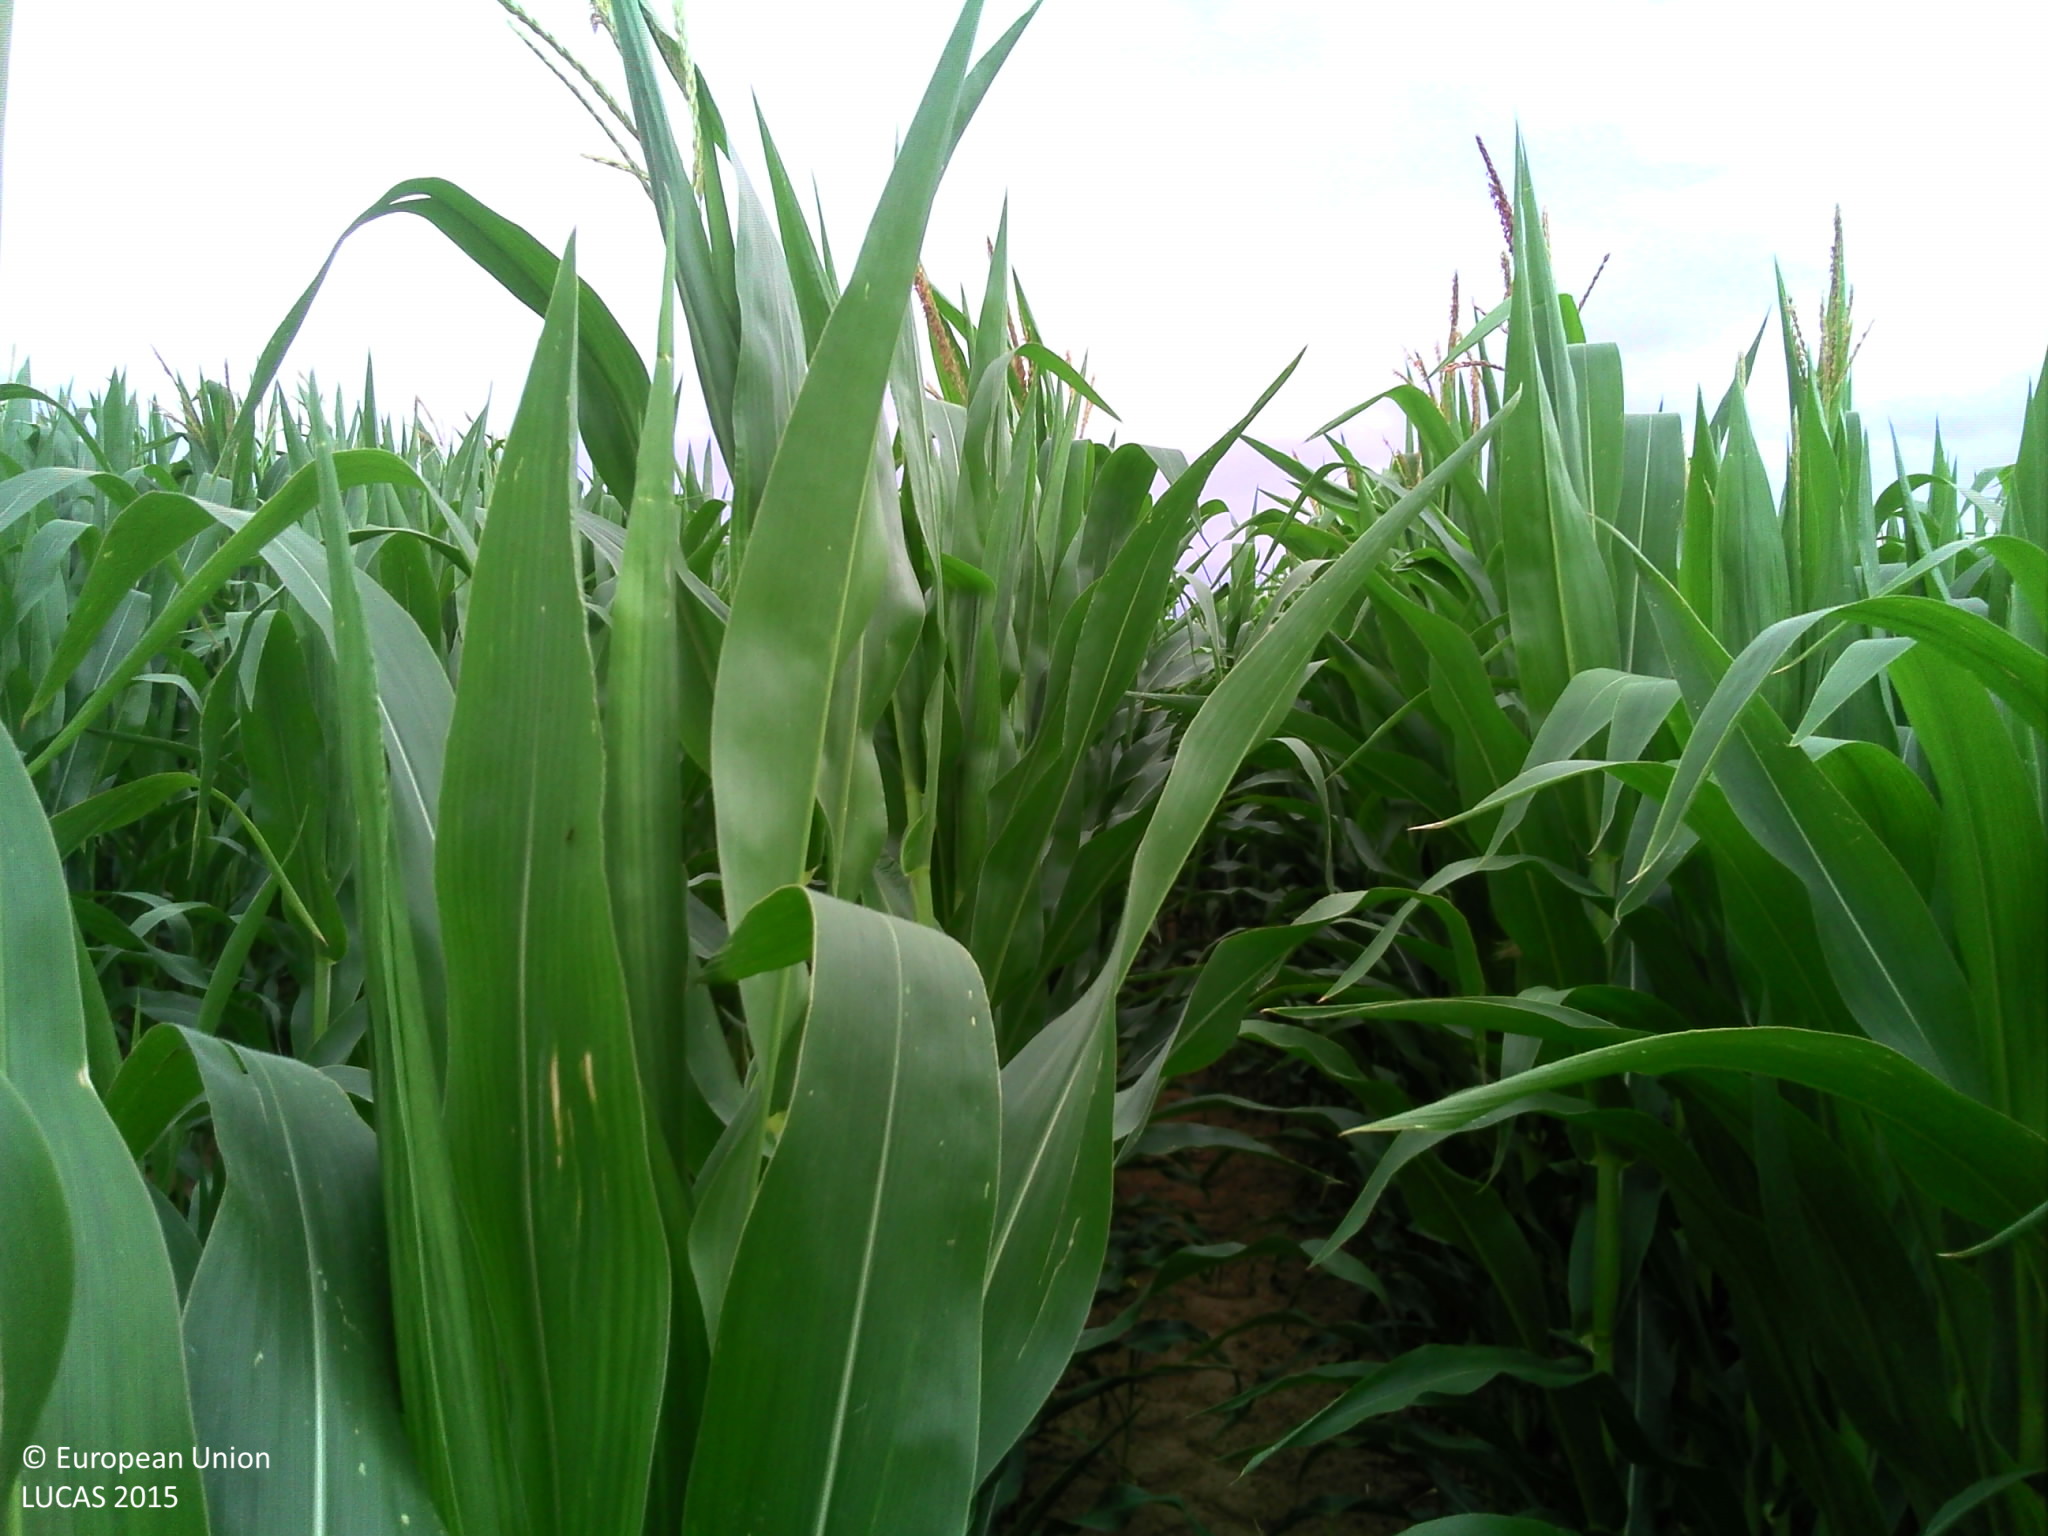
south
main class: Cropland
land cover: Maize
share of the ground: > 75 %
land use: Agriculture (excluding fallow land and kitchen gardens)
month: July
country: FR
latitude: 48.6492
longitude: 7.6797
